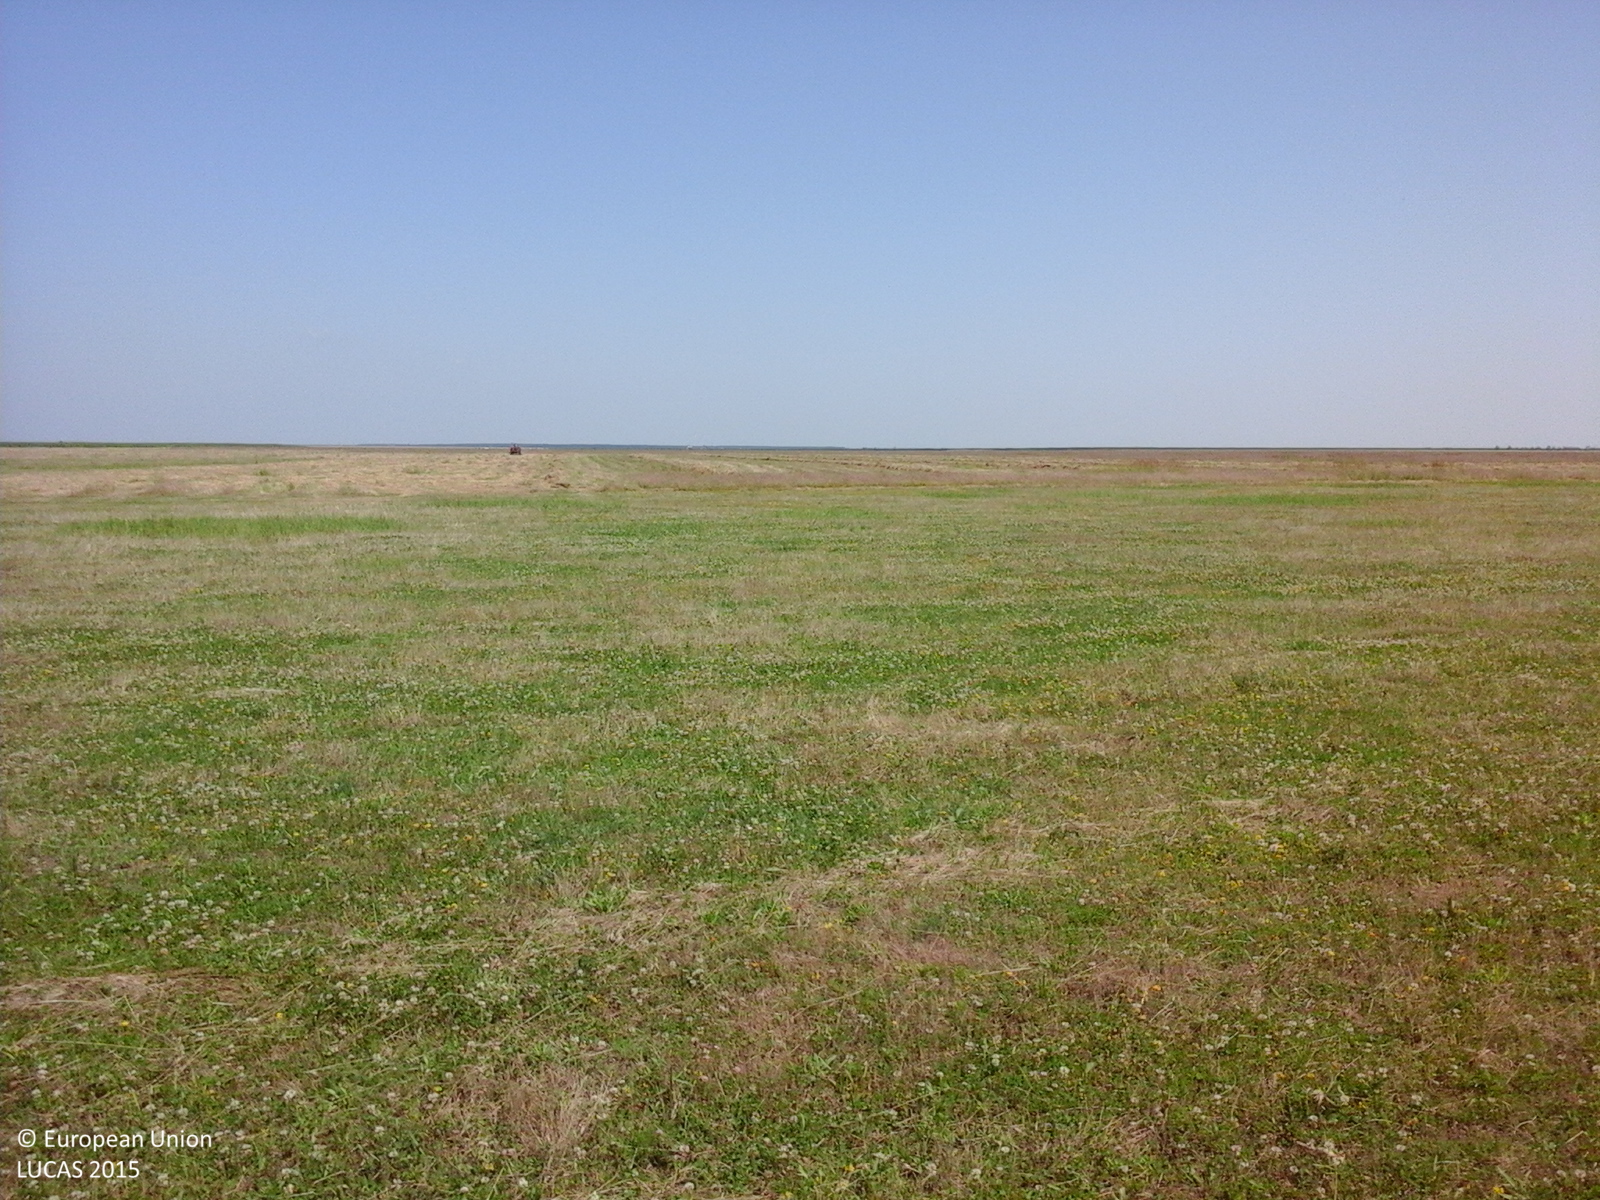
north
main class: Grassland
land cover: Grassland without tree/shrub cover
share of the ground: > 75 %
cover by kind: herbaceous plants 100 %
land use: Agriculture (excluding fallow land and kitchen gardens)
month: July
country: RO
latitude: 44.3847
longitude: 24.5180
